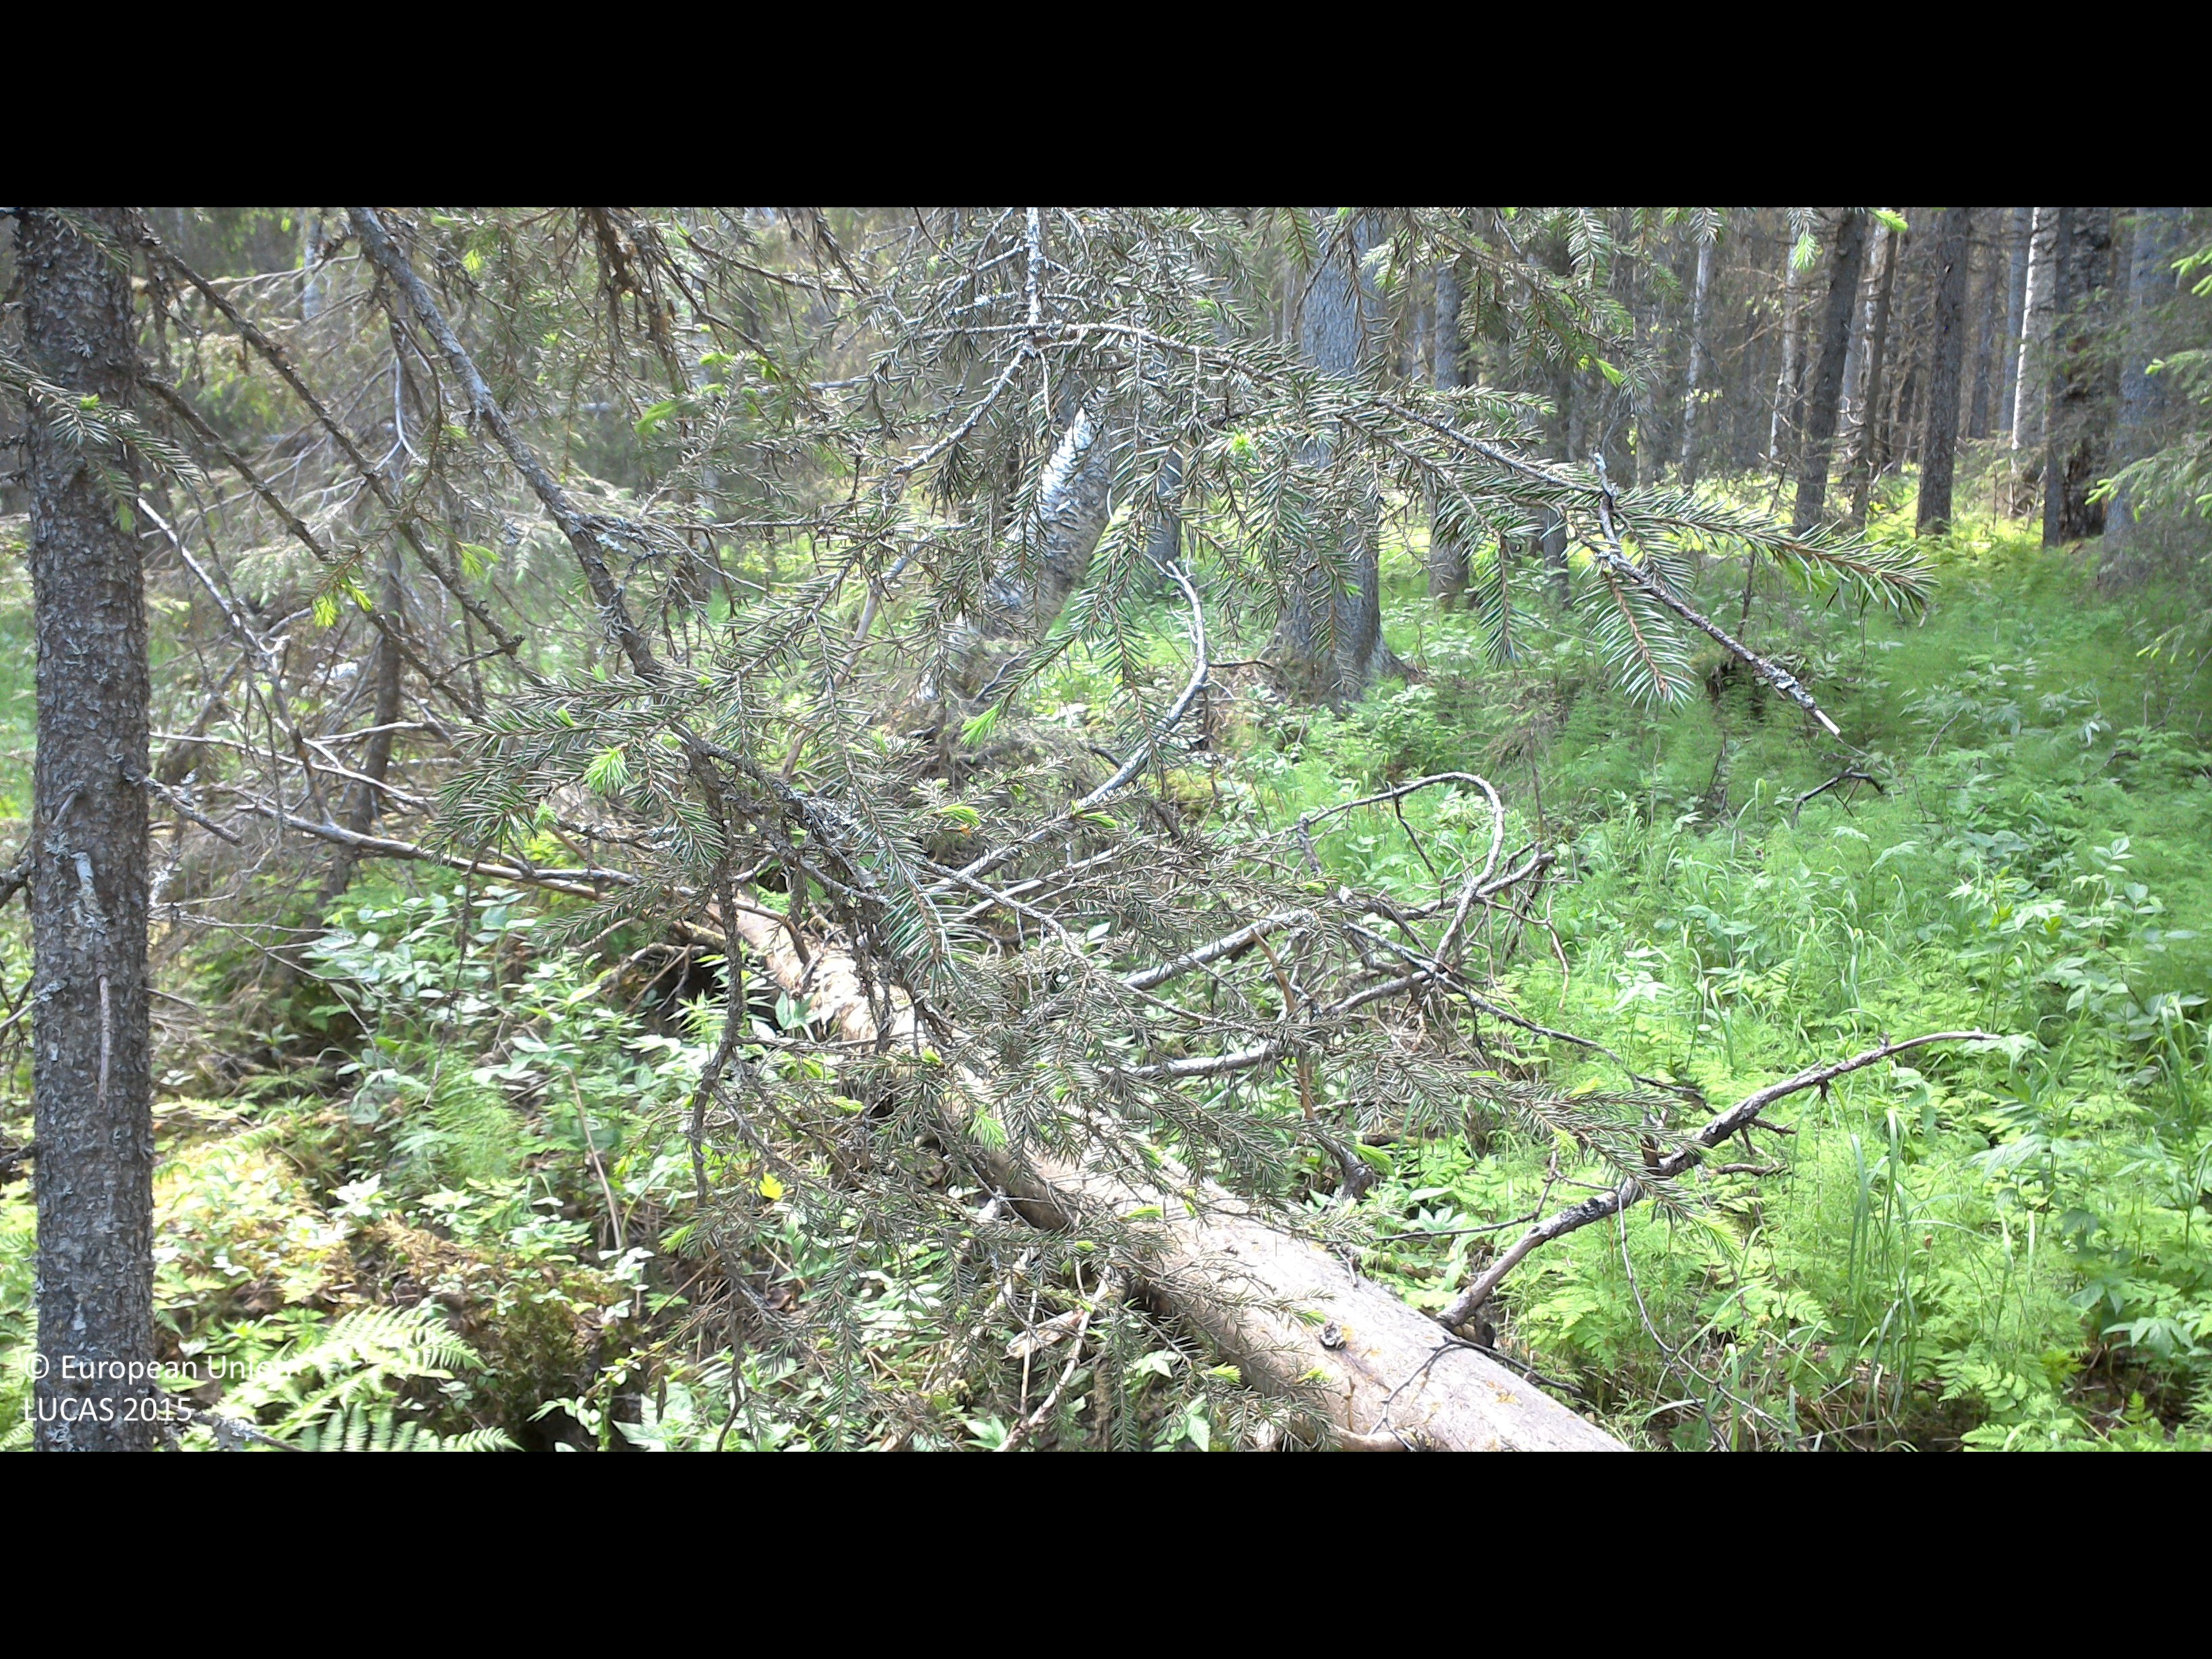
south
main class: Woodland
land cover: Spruce dominated mixed woodland
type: boreal forest
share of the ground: 25 - 50 %
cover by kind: herbaceous plants 65 %, coniferous forest trees 25 %, broadleaved forest trees 10 %
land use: Forestry
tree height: > 5 m
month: June
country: SE
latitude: 66.6440
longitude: 22.6526
